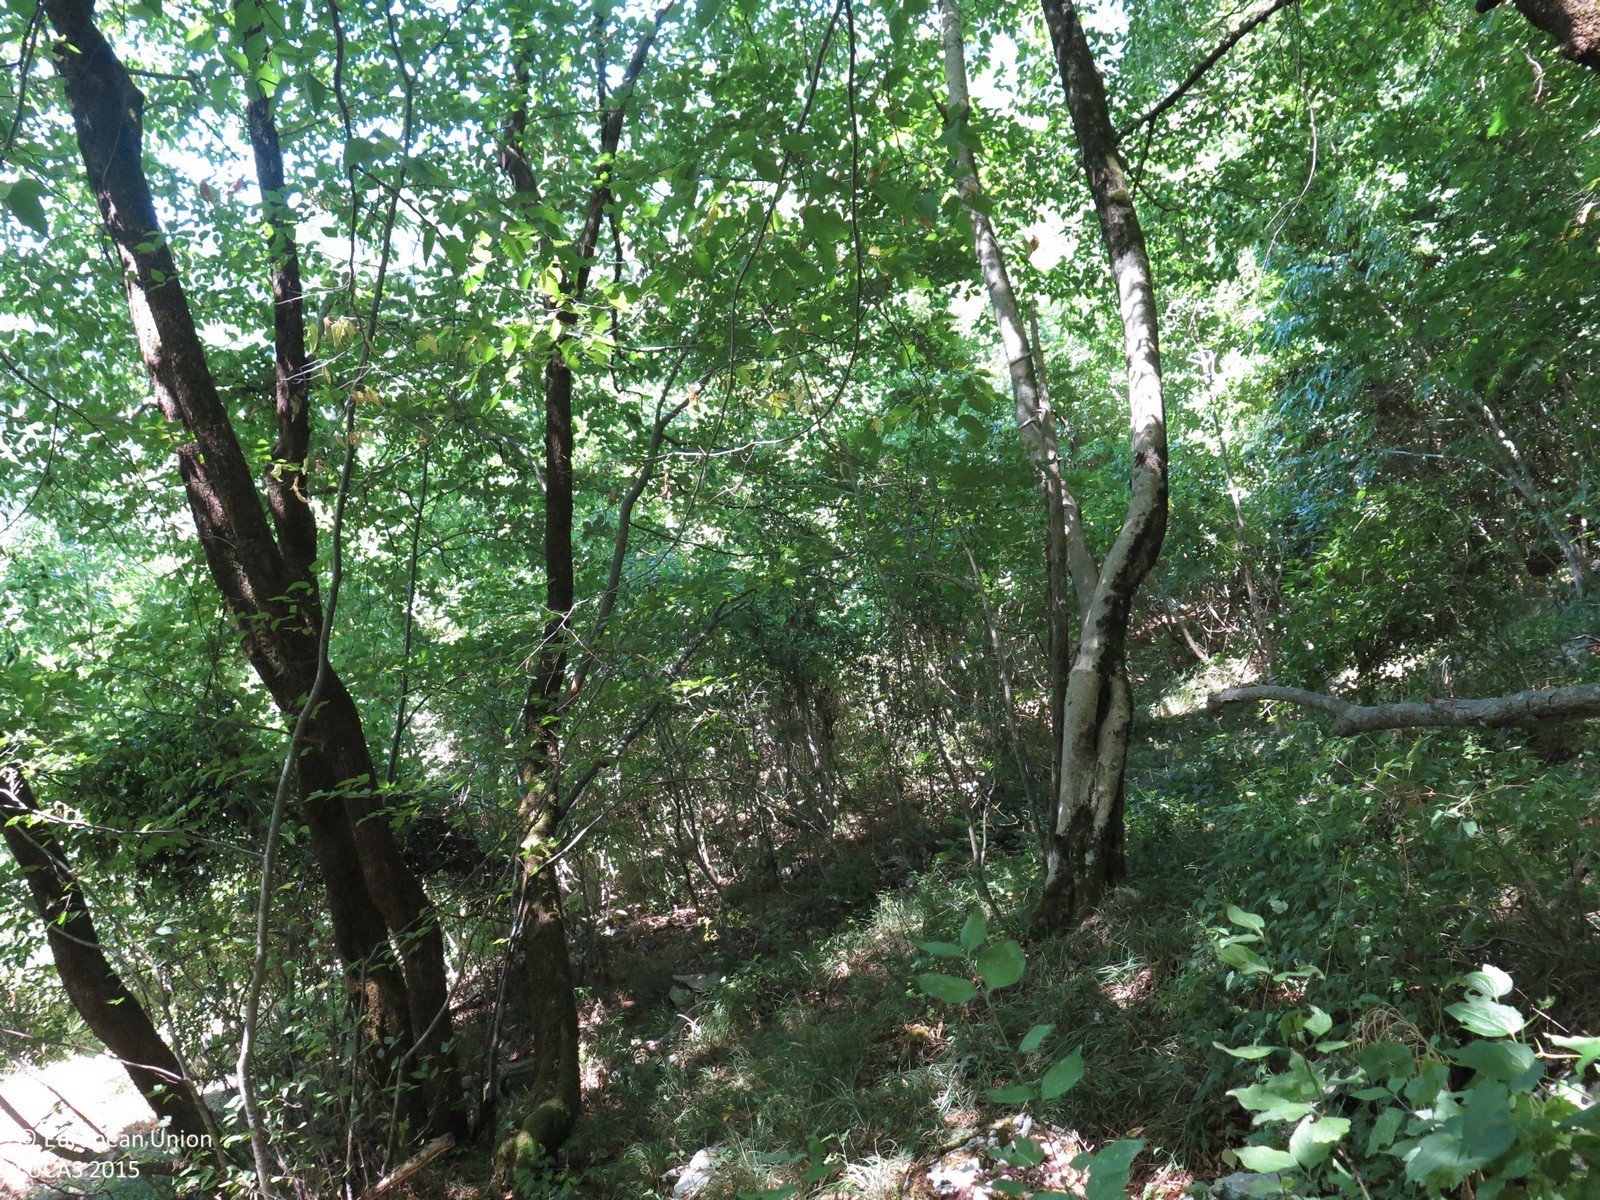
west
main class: Woodland
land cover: Broadleaved woodland
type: beech forest
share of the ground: > 75 %
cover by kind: broadleaved forest trees 90 %, herbaceous plants 5 %, unconsolidated bare surface 5 %
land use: Semi-natural and natural areas not in use
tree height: > 5 m
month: August
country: HR
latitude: 45.2150
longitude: 14.7954
